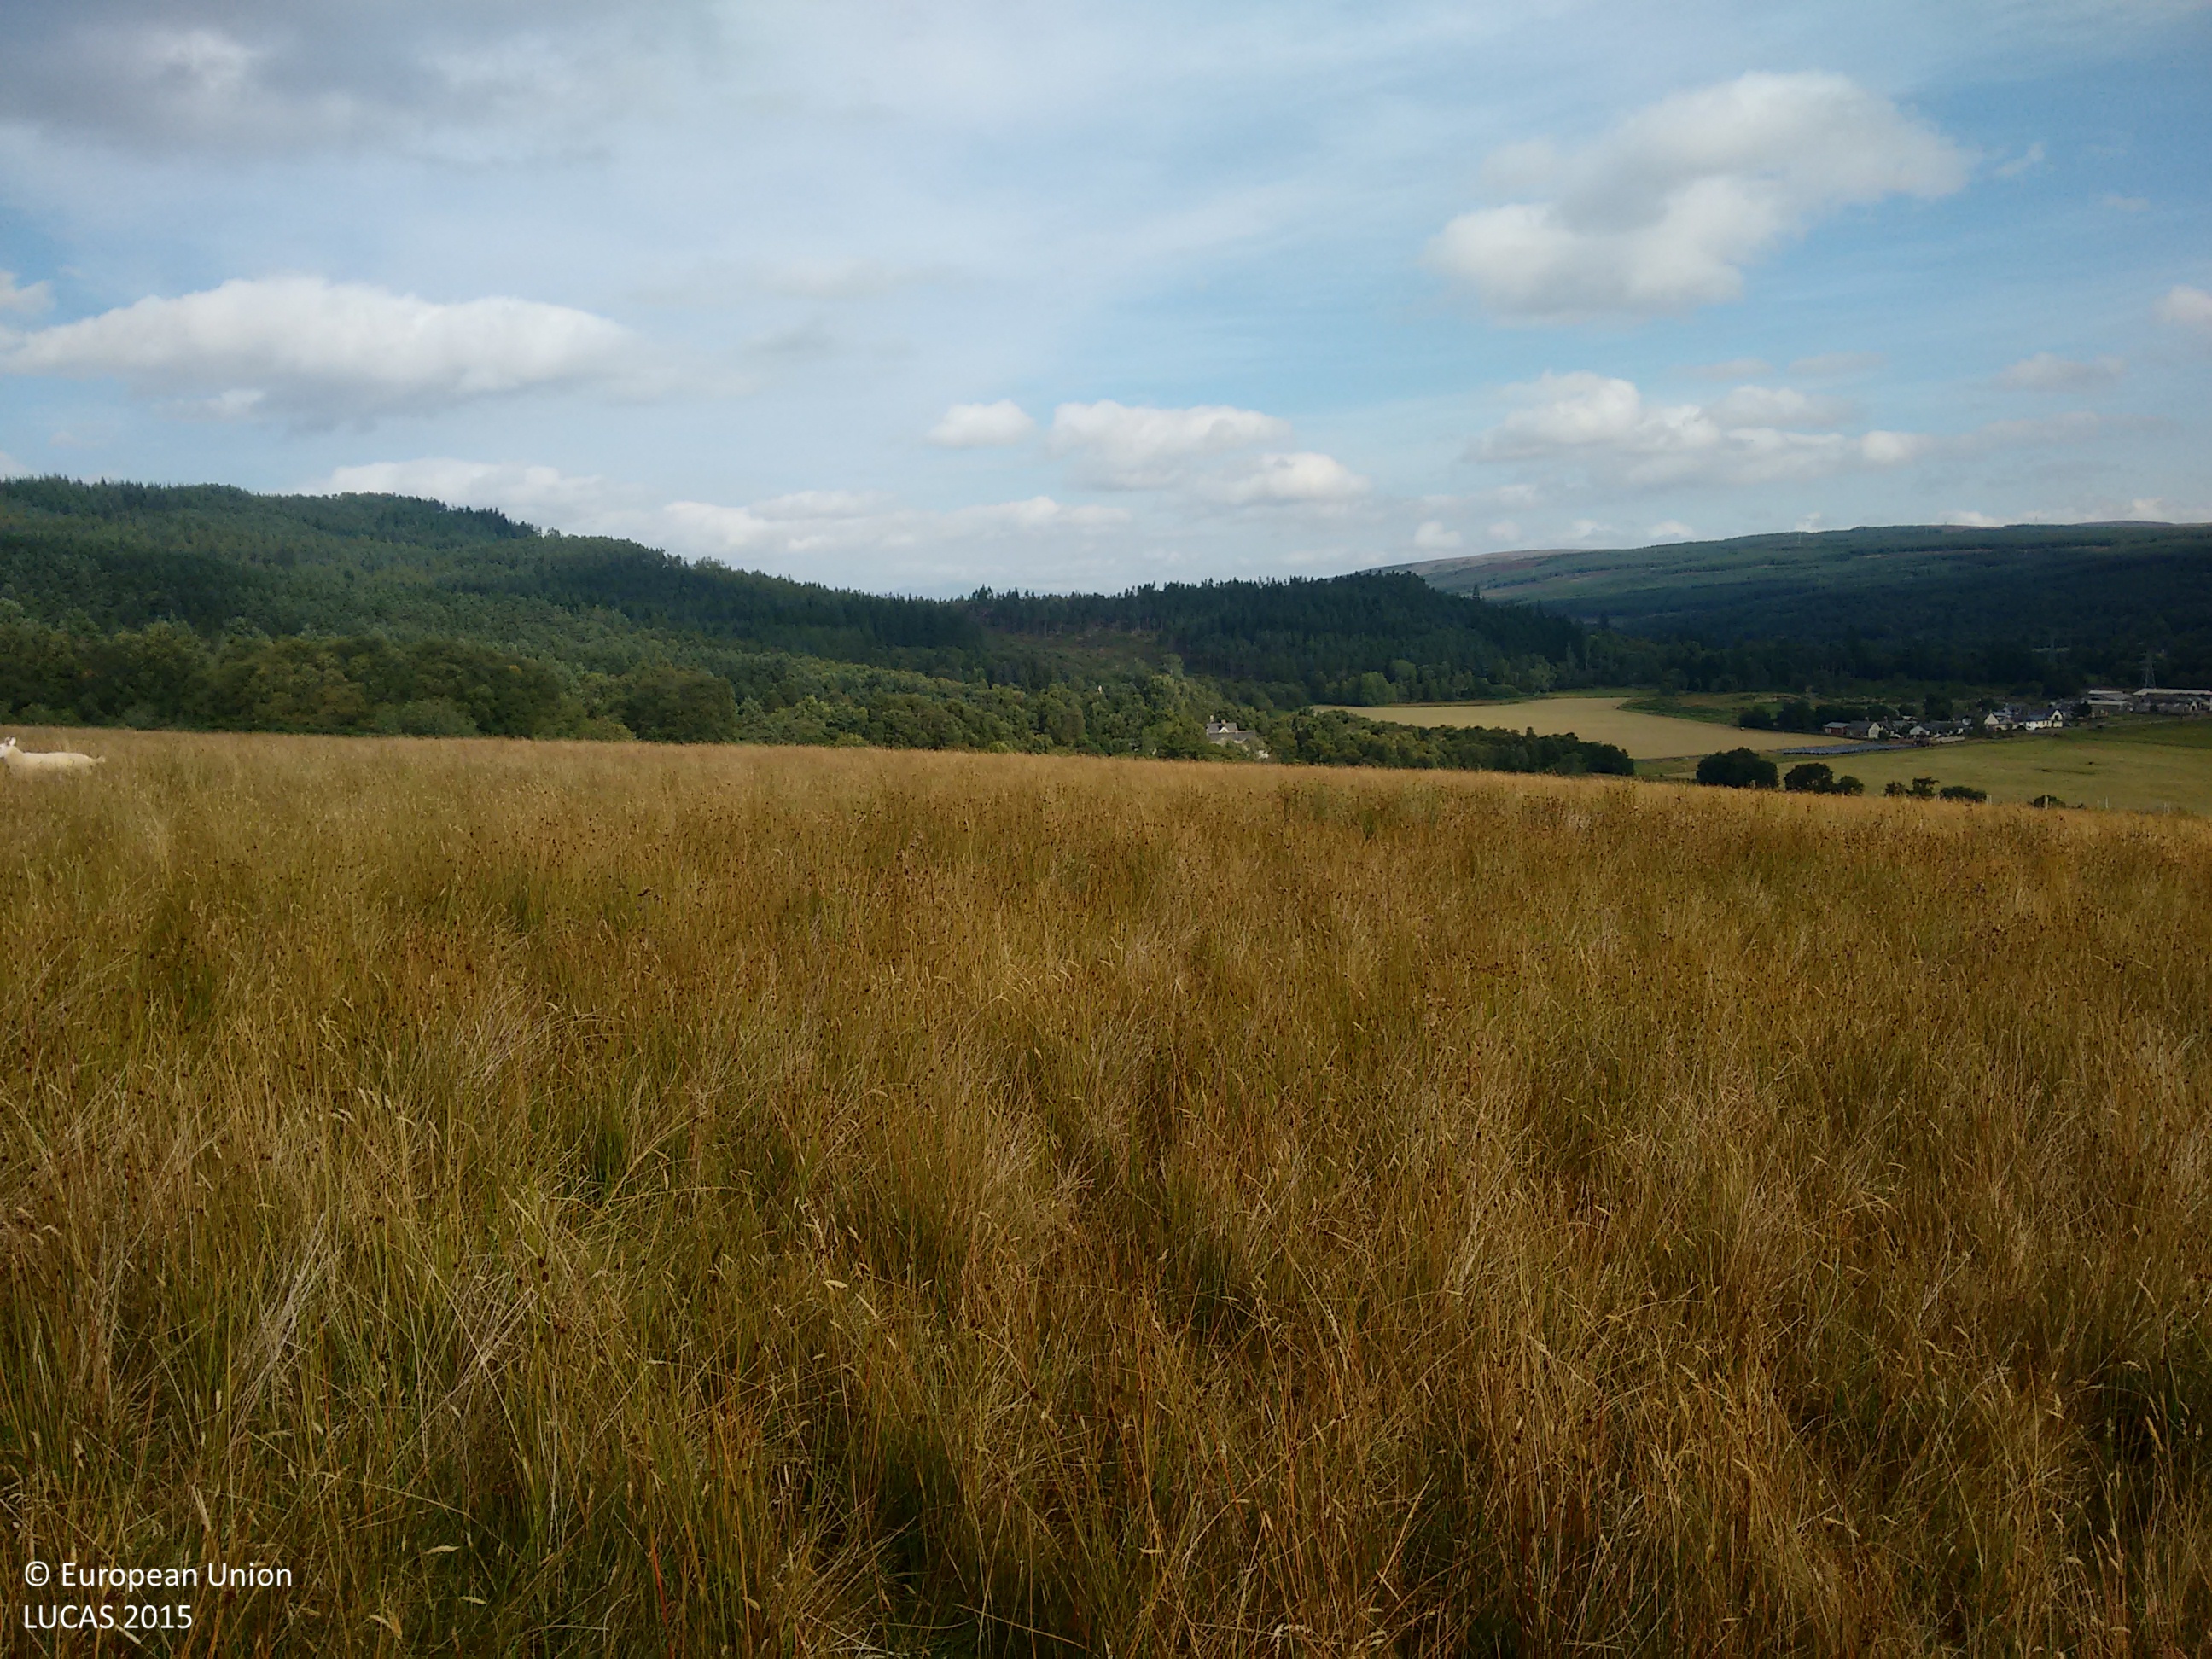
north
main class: Grassland
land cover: Grassland without tree/shrub cover
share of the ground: > 75 %
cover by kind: herbaceous plants 100 %
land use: Agriculture (excluding fallow land and kitchen gardens)
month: September
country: GB
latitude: 57.9127
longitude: -4.4164
